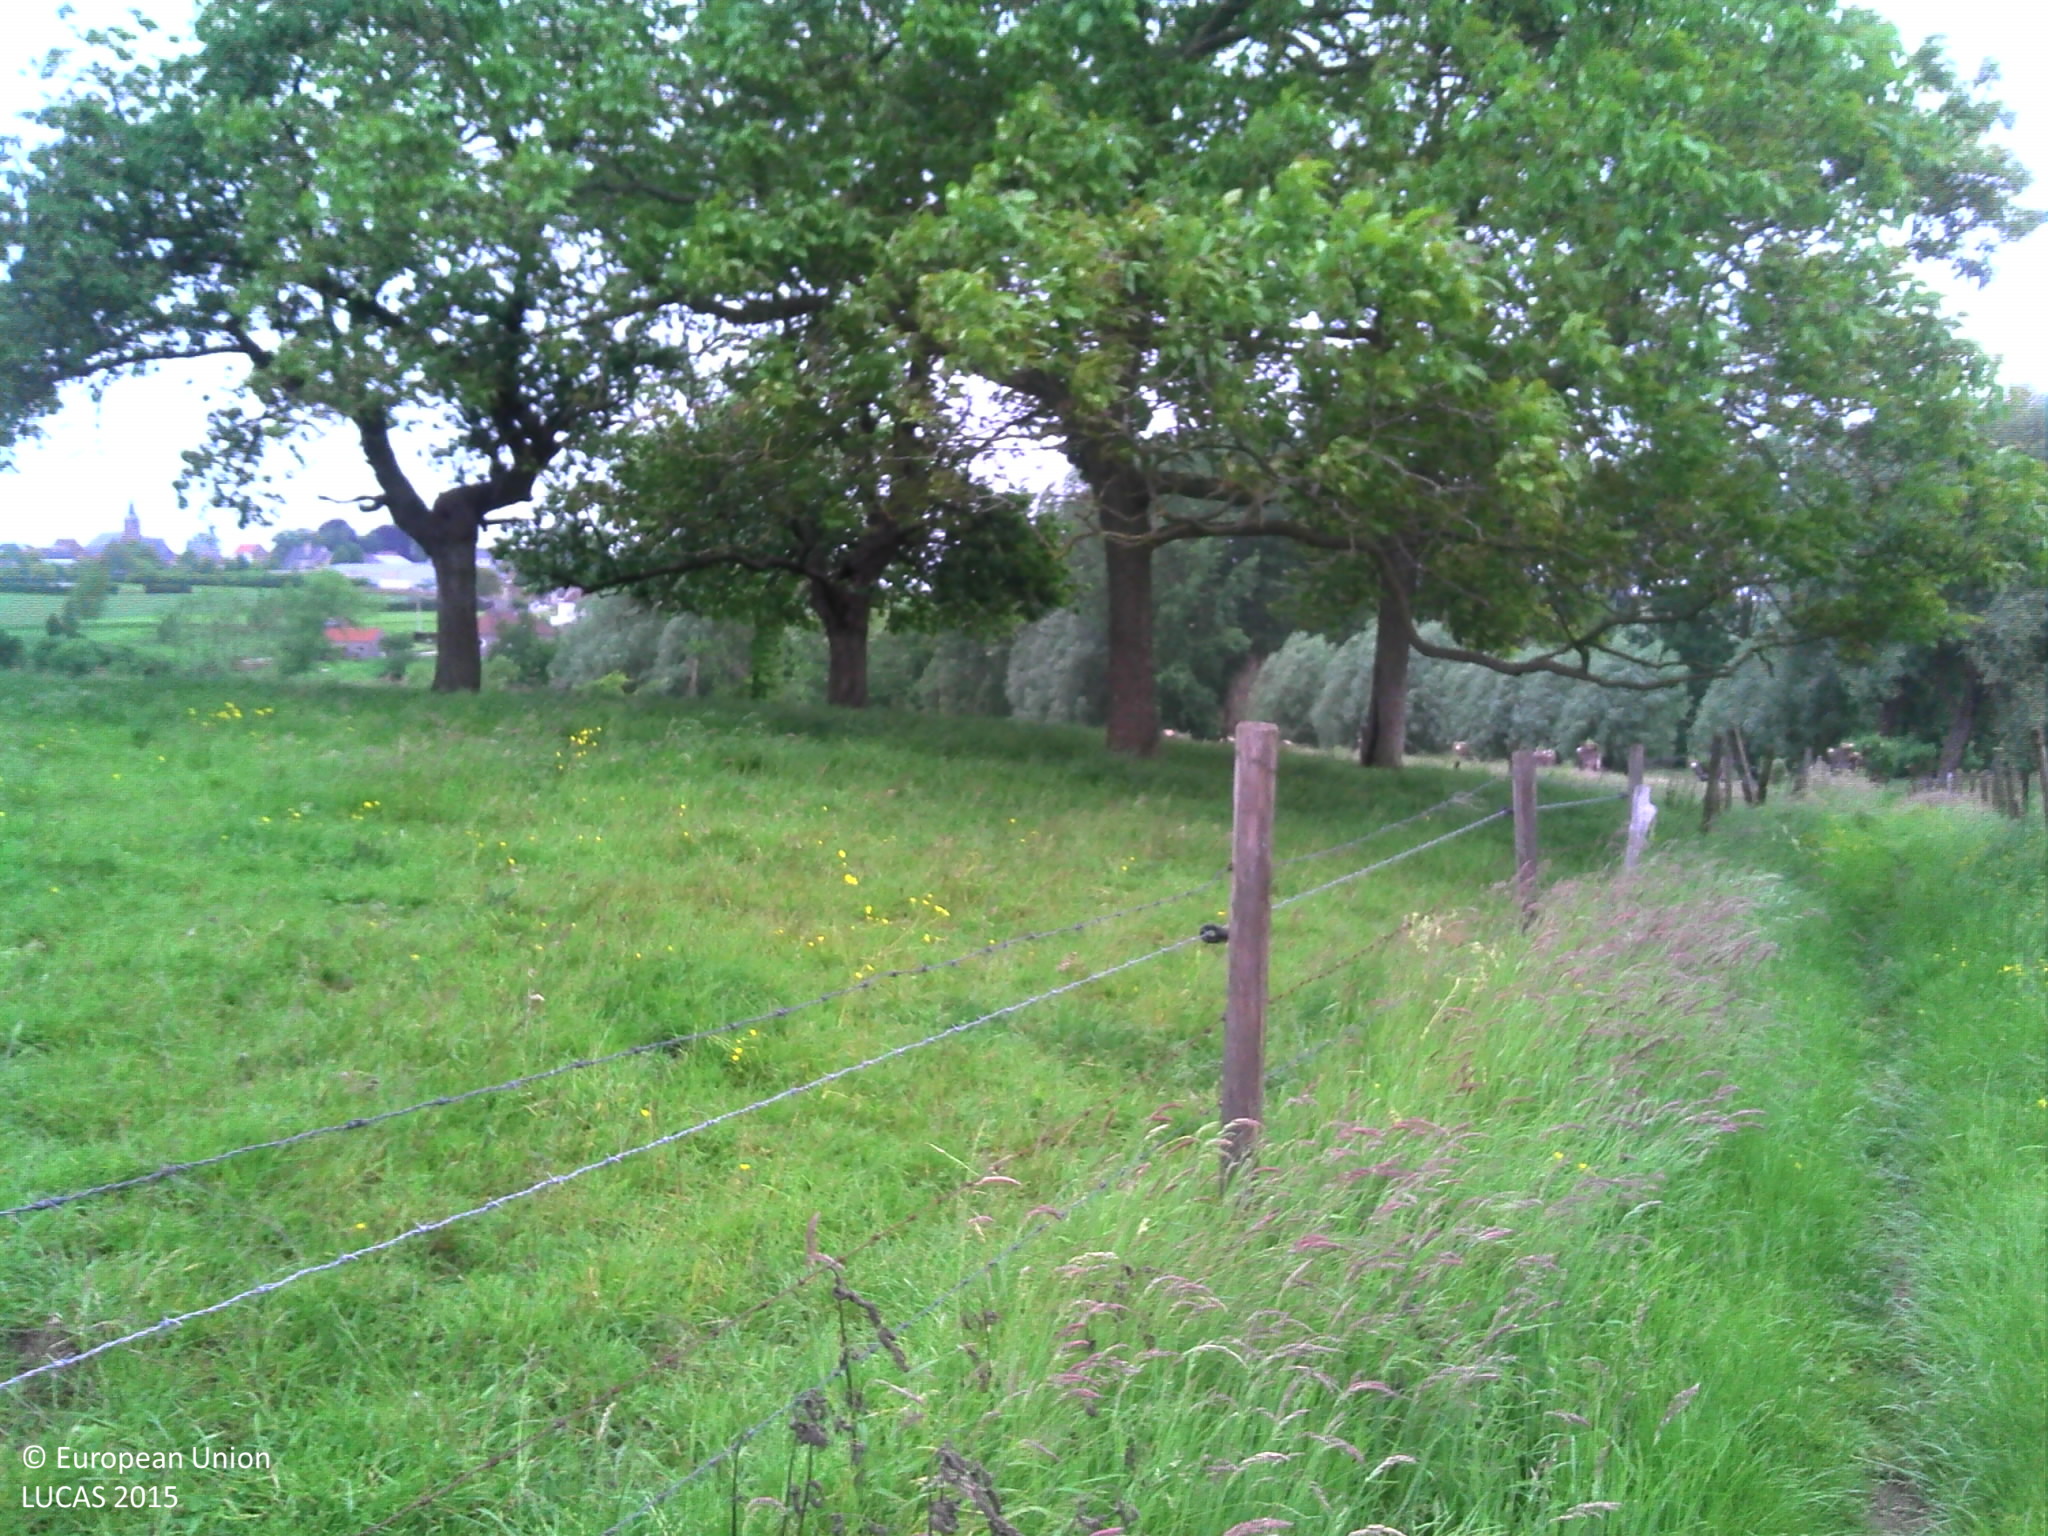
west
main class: Grassland
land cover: Grassland without tree/shrub cover
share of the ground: > 75 %
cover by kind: herbaceous plants 100 %
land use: Residential
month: June
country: BE
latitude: 50.8398
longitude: 3.7021
